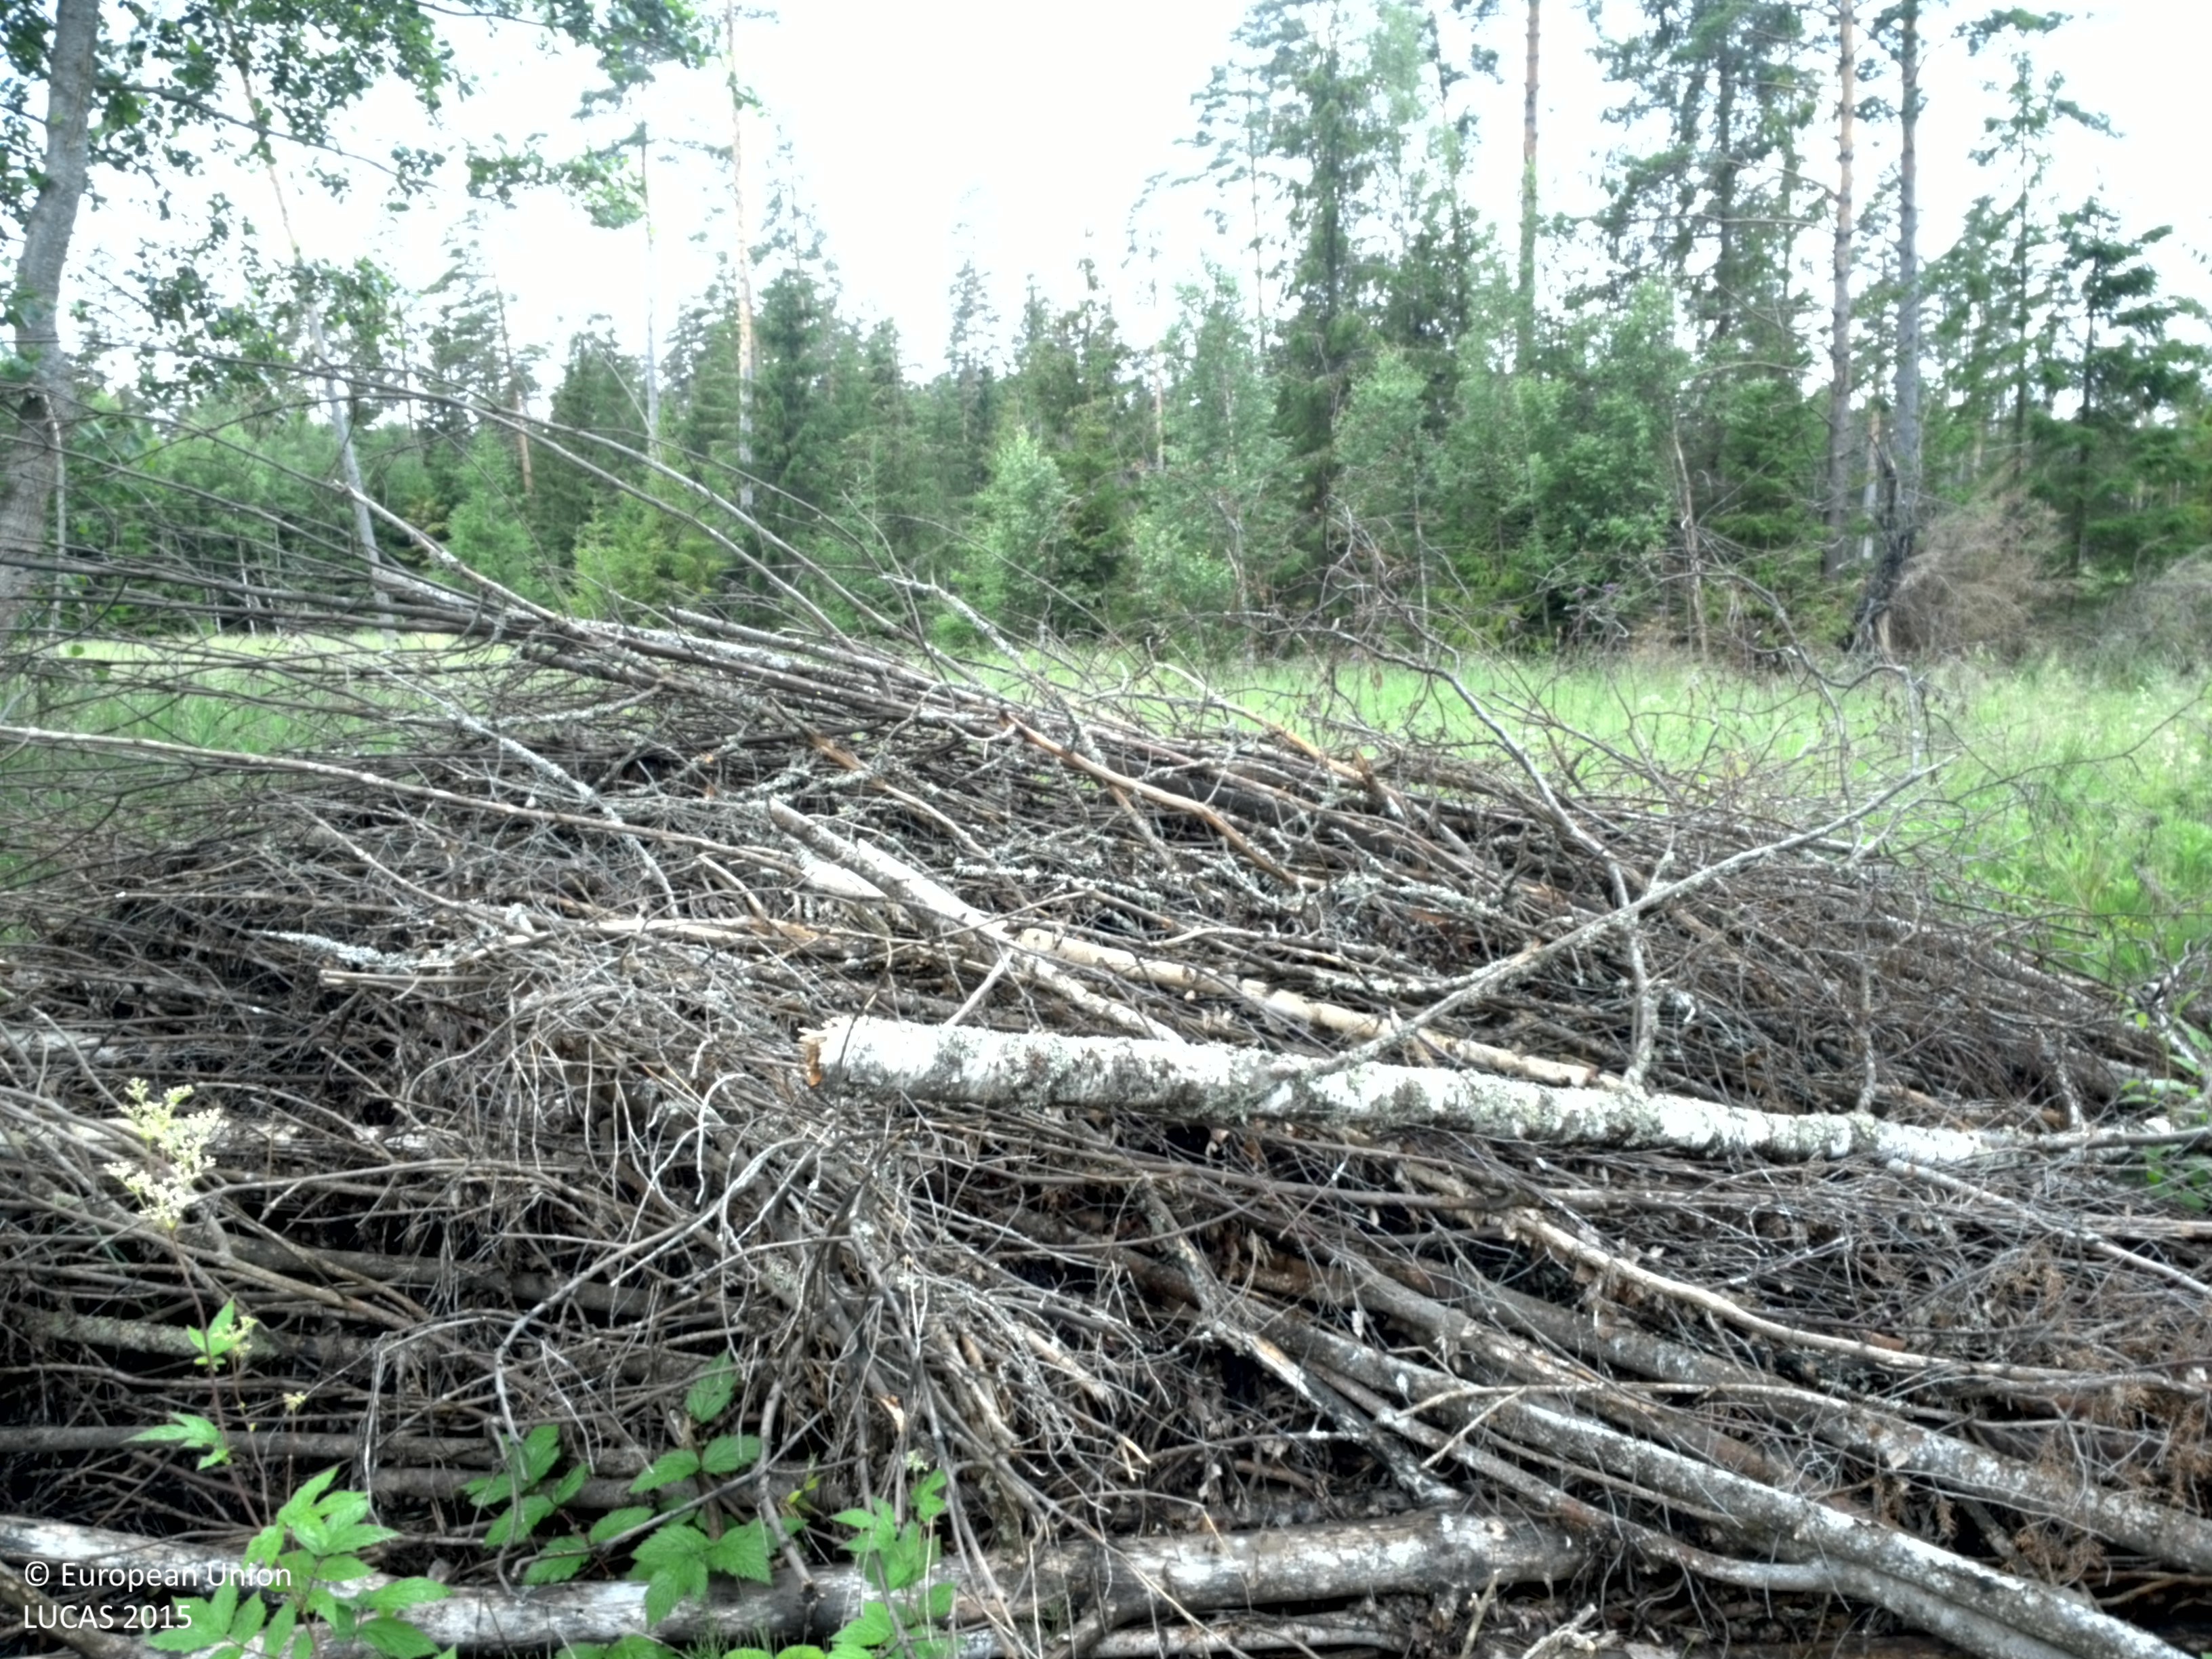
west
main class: Woodland
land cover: Broadleaved woodland
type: hemiboreal forest and nemoral coniferous forest and mixed broadleaved-coniferous forest
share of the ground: 25 - 50 %
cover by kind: herbaceous plants 60 %, broadleaved forest trees 25 %, shrubs 10 %, coniferous forest trees 5 %
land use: Forestry
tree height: > 5 m
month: July
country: SE
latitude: 60.1426
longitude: 17.1766
